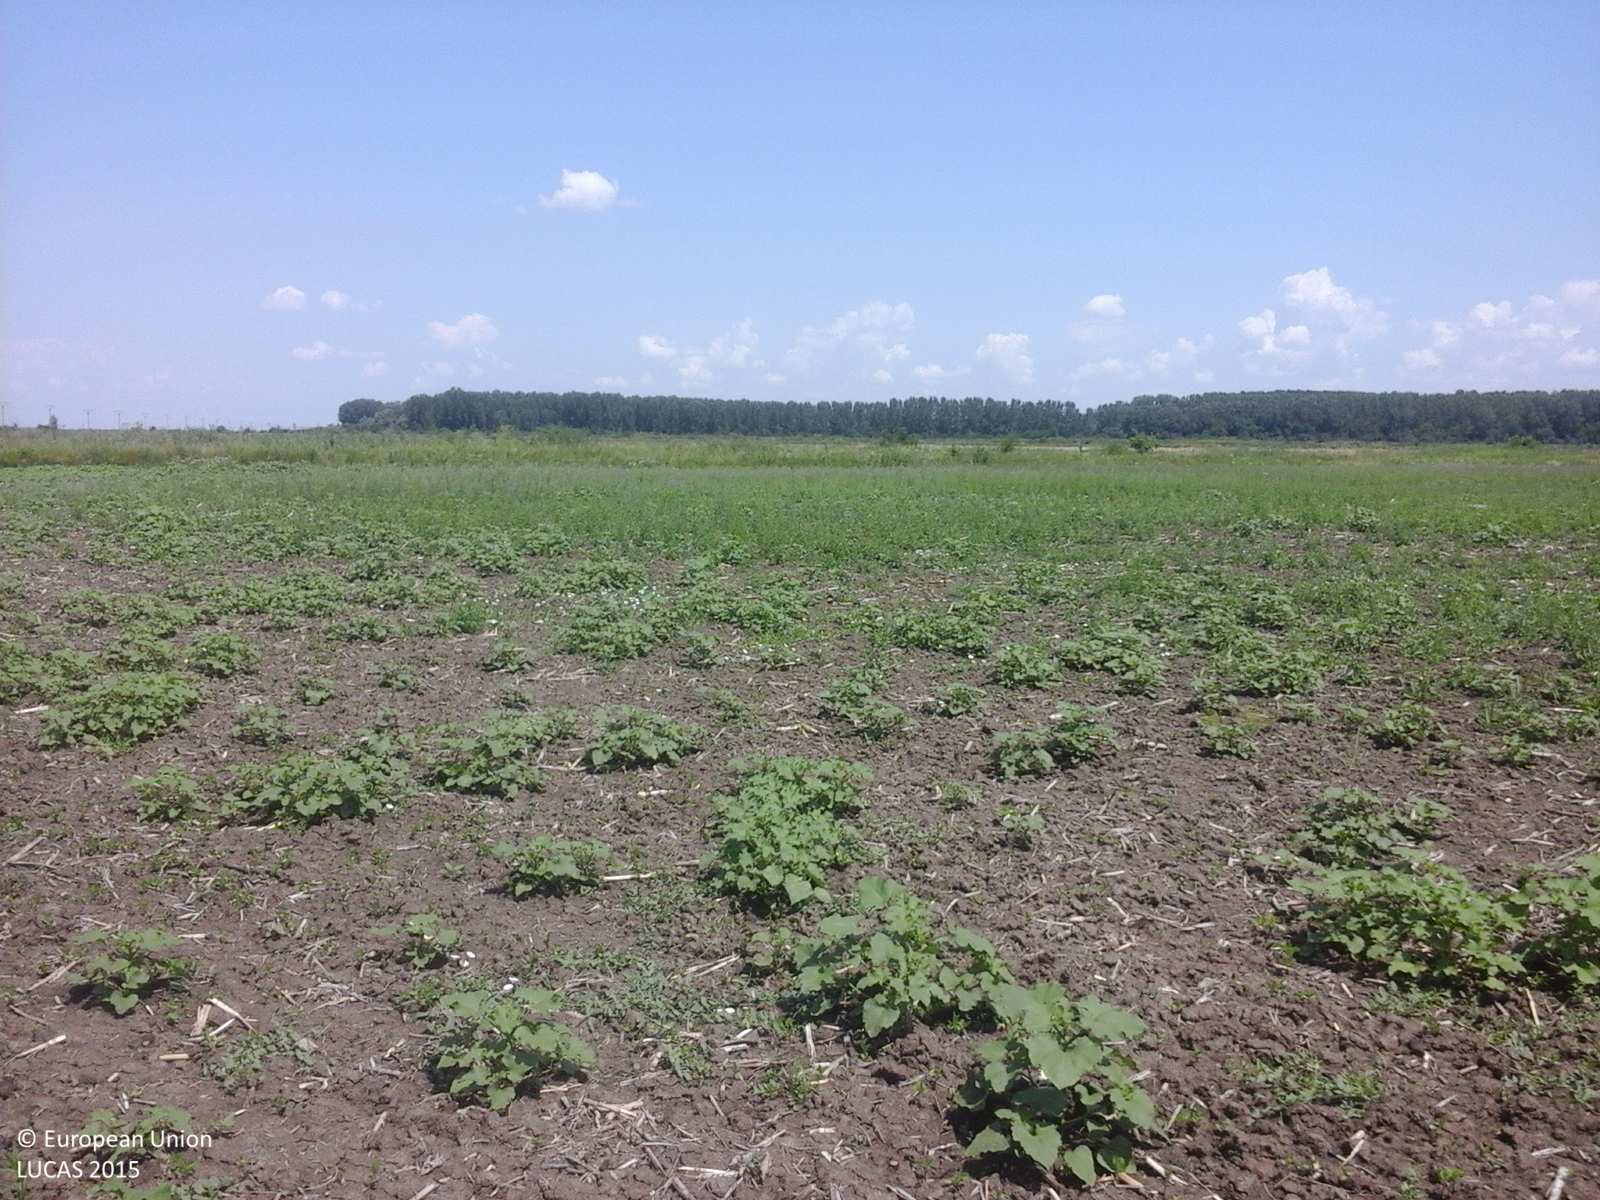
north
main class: Cropland
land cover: Soya
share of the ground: < 10 %
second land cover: Spontaneously vegetated surfaces
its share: 25 - 50 %
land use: Agriculture (excluding fallow land and kitchen gardens)
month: June
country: RO
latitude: 44.0674
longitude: 26.6064
